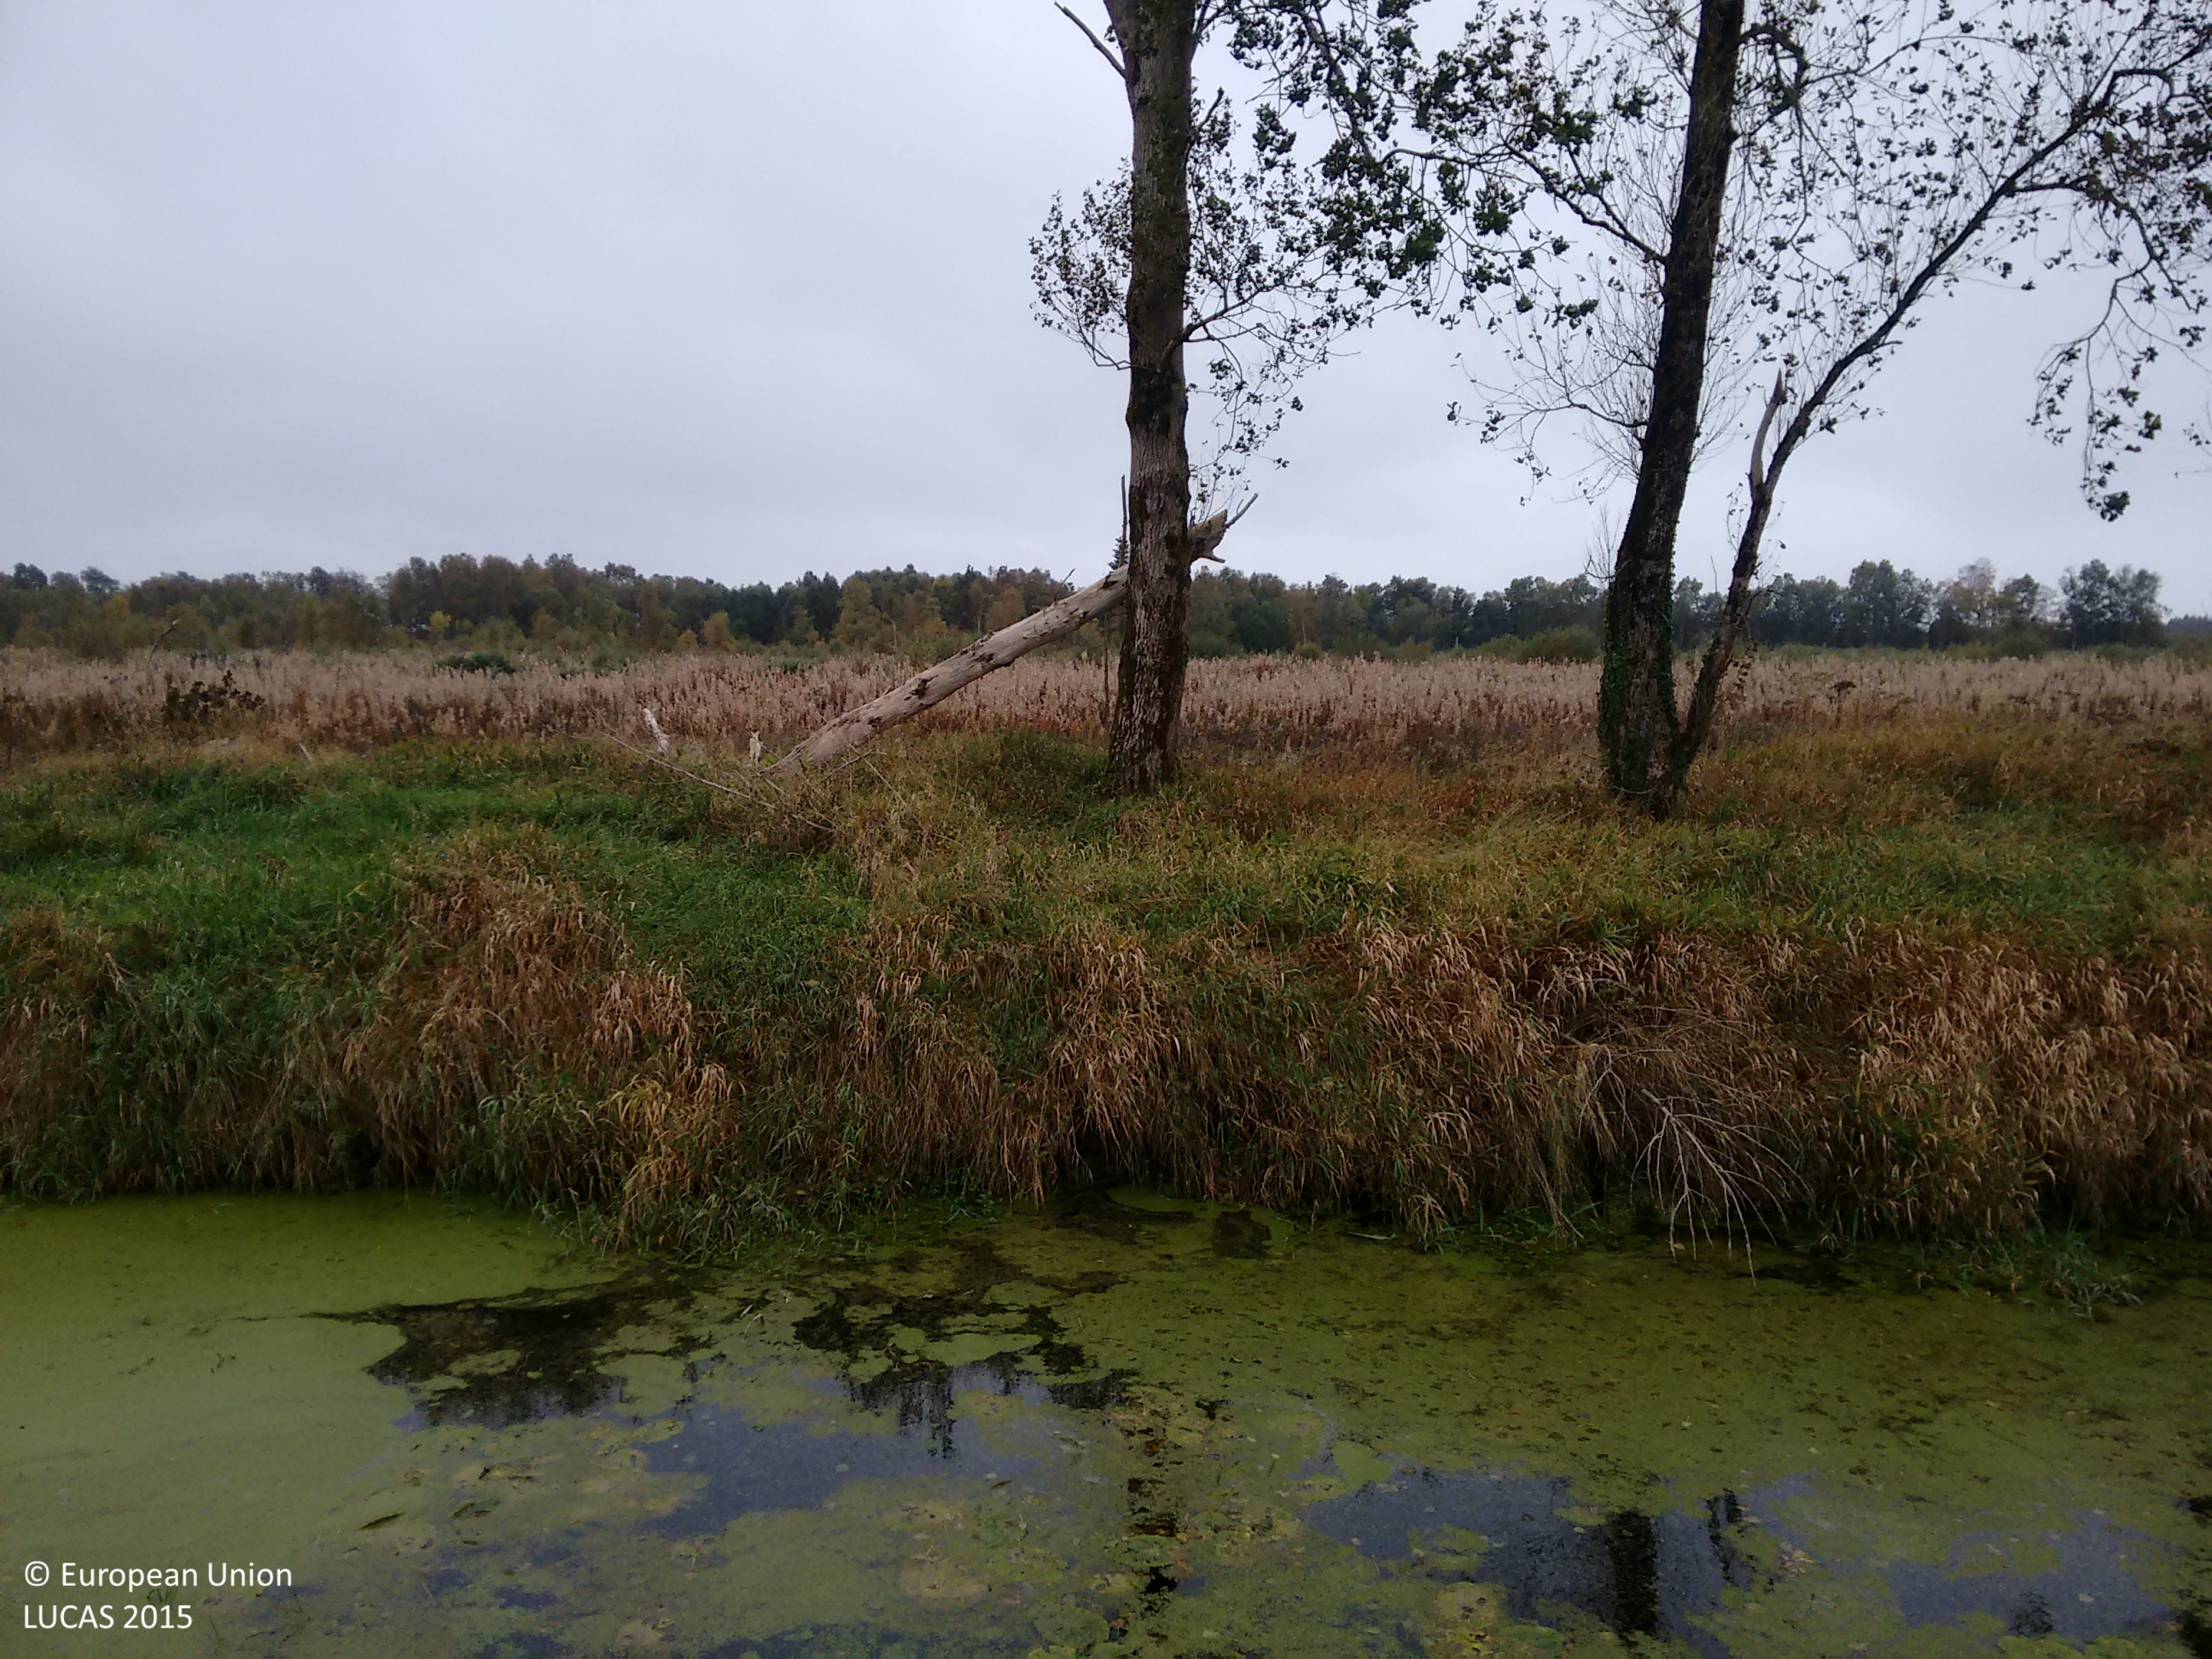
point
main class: Grassland
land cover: Grassland without tree/shrub cover
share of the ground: > 75 %
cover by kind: herbaceous plants 100 %
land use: Semi-natural and natural areas not in use
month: October
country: IE
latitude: 52.7171
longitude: -7.6472
